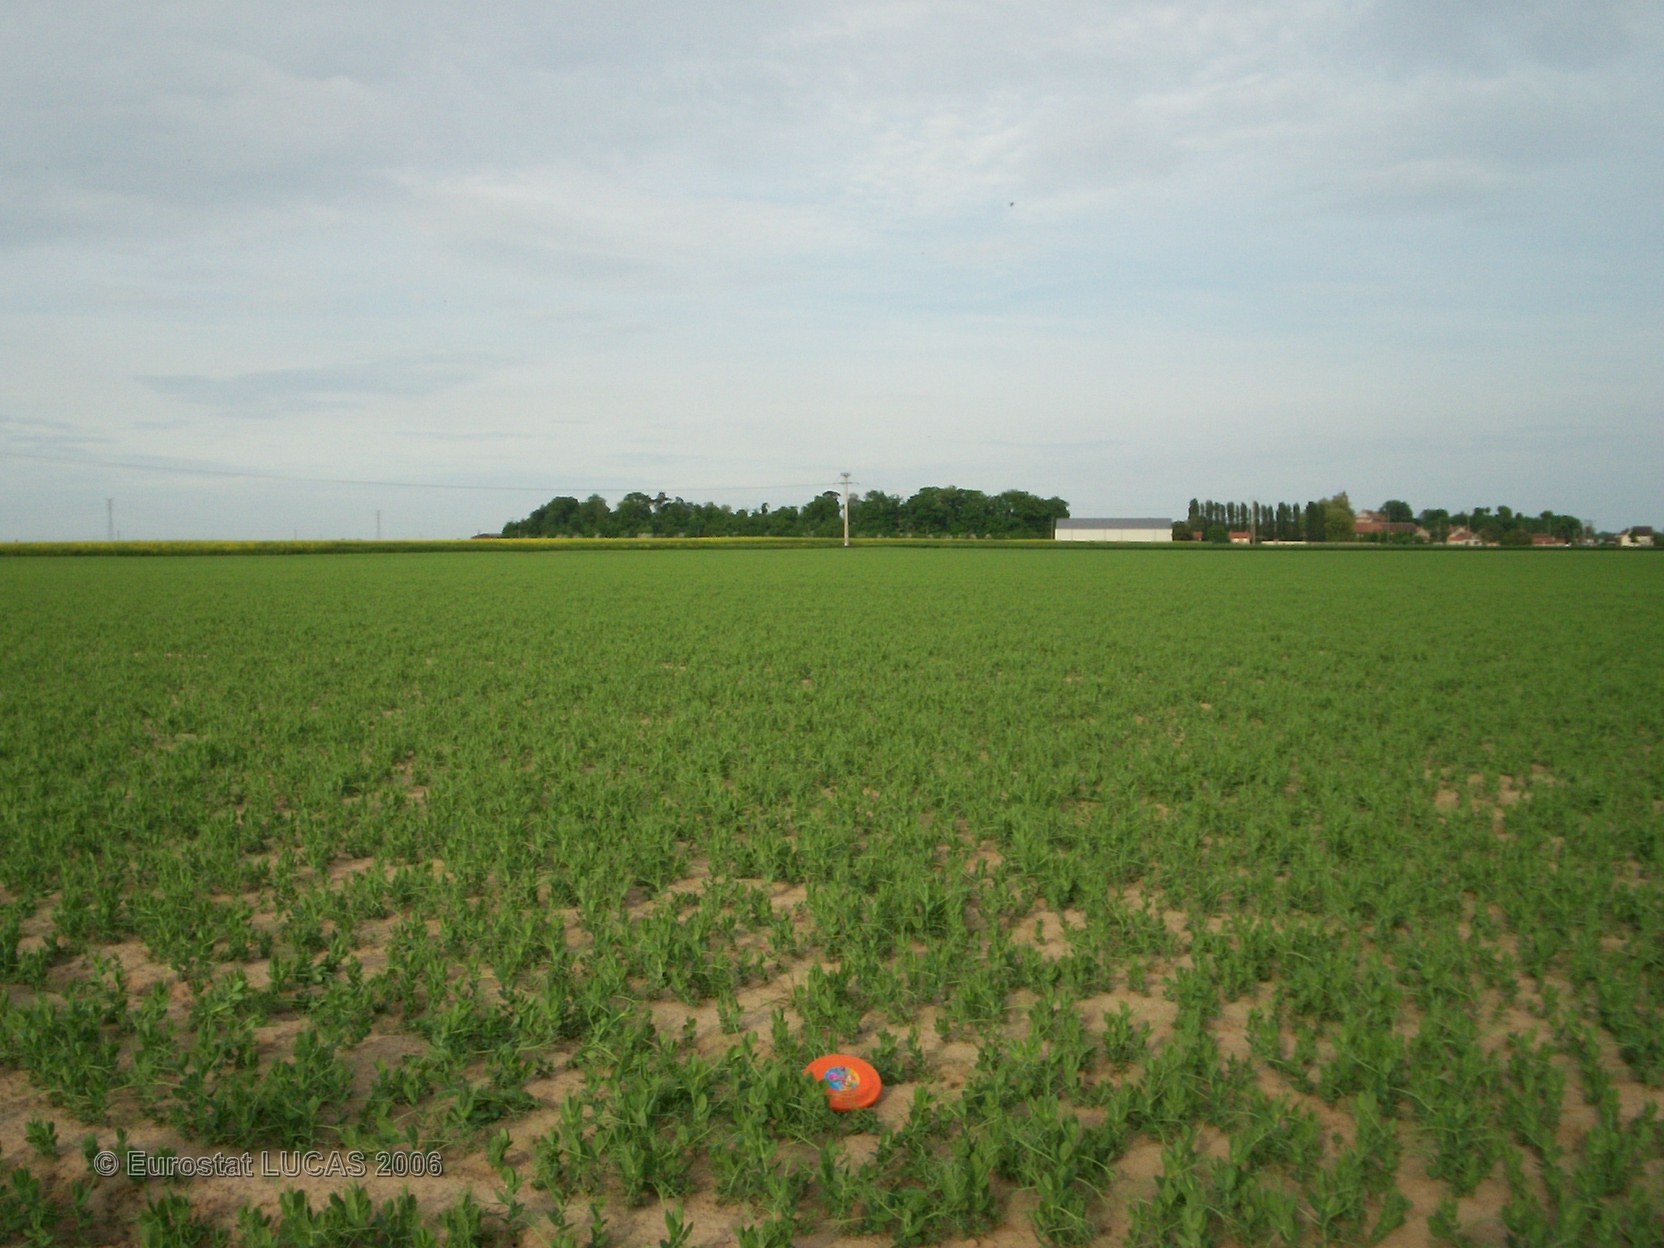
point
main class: Cropland
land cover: Dry pulses
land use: Agriculture (excluding fallow land and kitchen gardens)
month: May
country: FR
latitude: 48.5836
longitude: 2.7925
